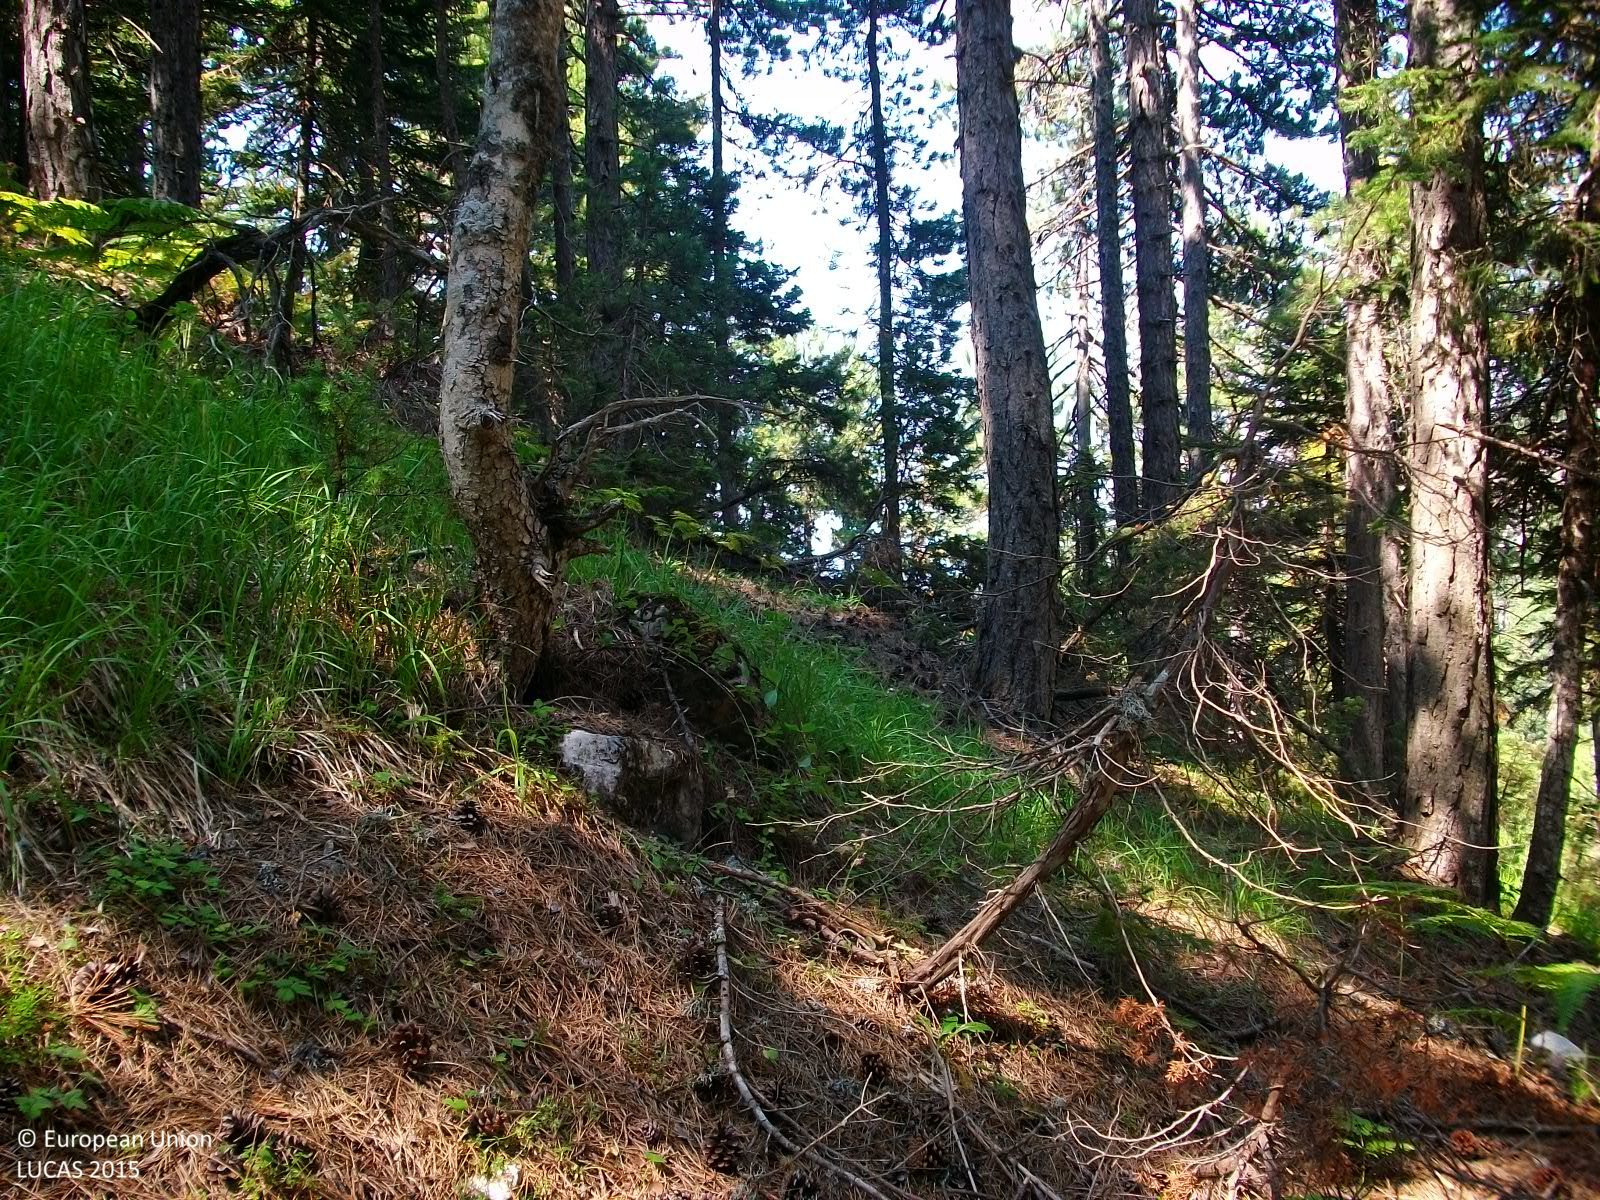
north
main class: Woodland
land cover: Spruce dominated mixed woodland
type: coniferous forest of the mediterranean region
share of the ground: > 75 %
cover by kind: coniferous forest trees 65 %, broadleaved forest trees 25 %, herbaceous plants 10 %
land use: Forestry
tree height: > 5 m
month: July
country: GR
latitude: 38.5949
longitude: 22.5731
